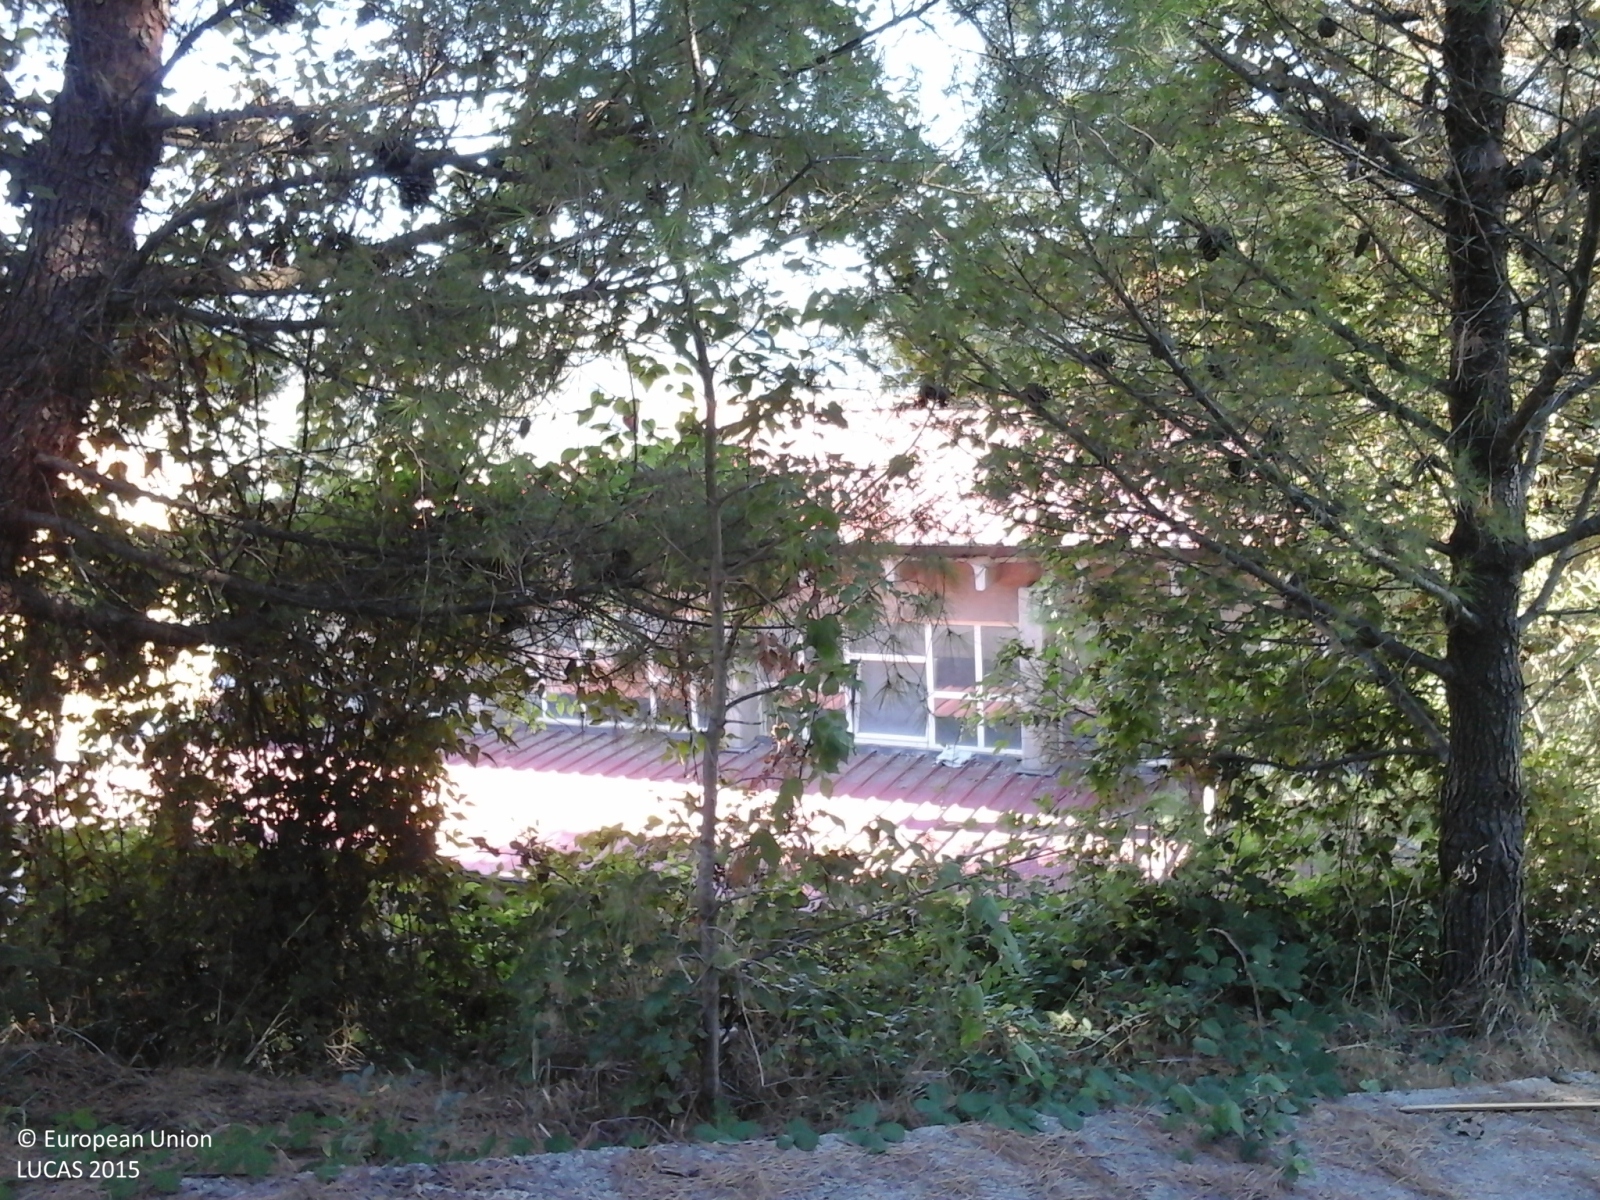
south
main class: Cropland
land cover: Other fruit trees and berries
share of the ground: > 75 %
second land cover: Spontaneously vegetated surfaces
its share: > 75 %
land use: Kitchen garden
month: August
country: IT
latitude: 40.2993
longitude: 15.0718
